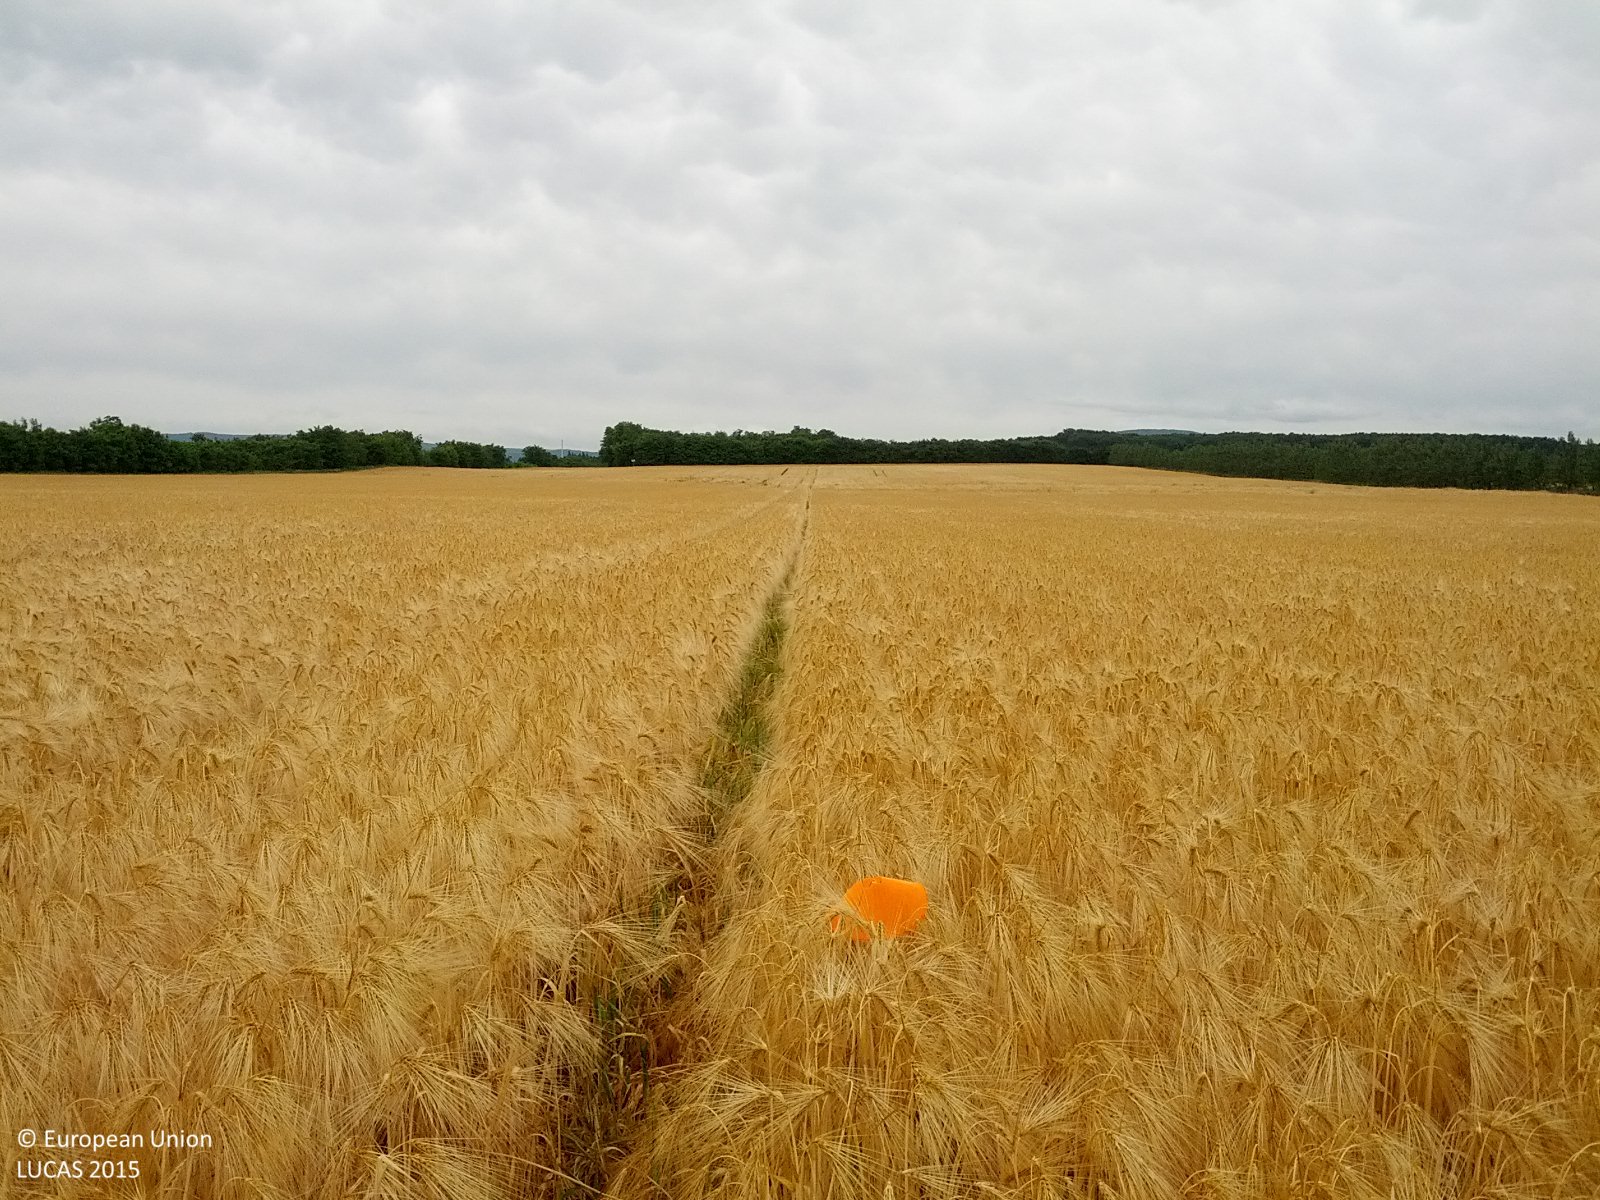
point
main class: Cropland
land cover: Barley
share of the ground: > 75 %
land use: Agriculture (excluding fallow land and kitchen gardens)
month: June
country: AT
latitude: 48.2607
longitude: 16.8906
